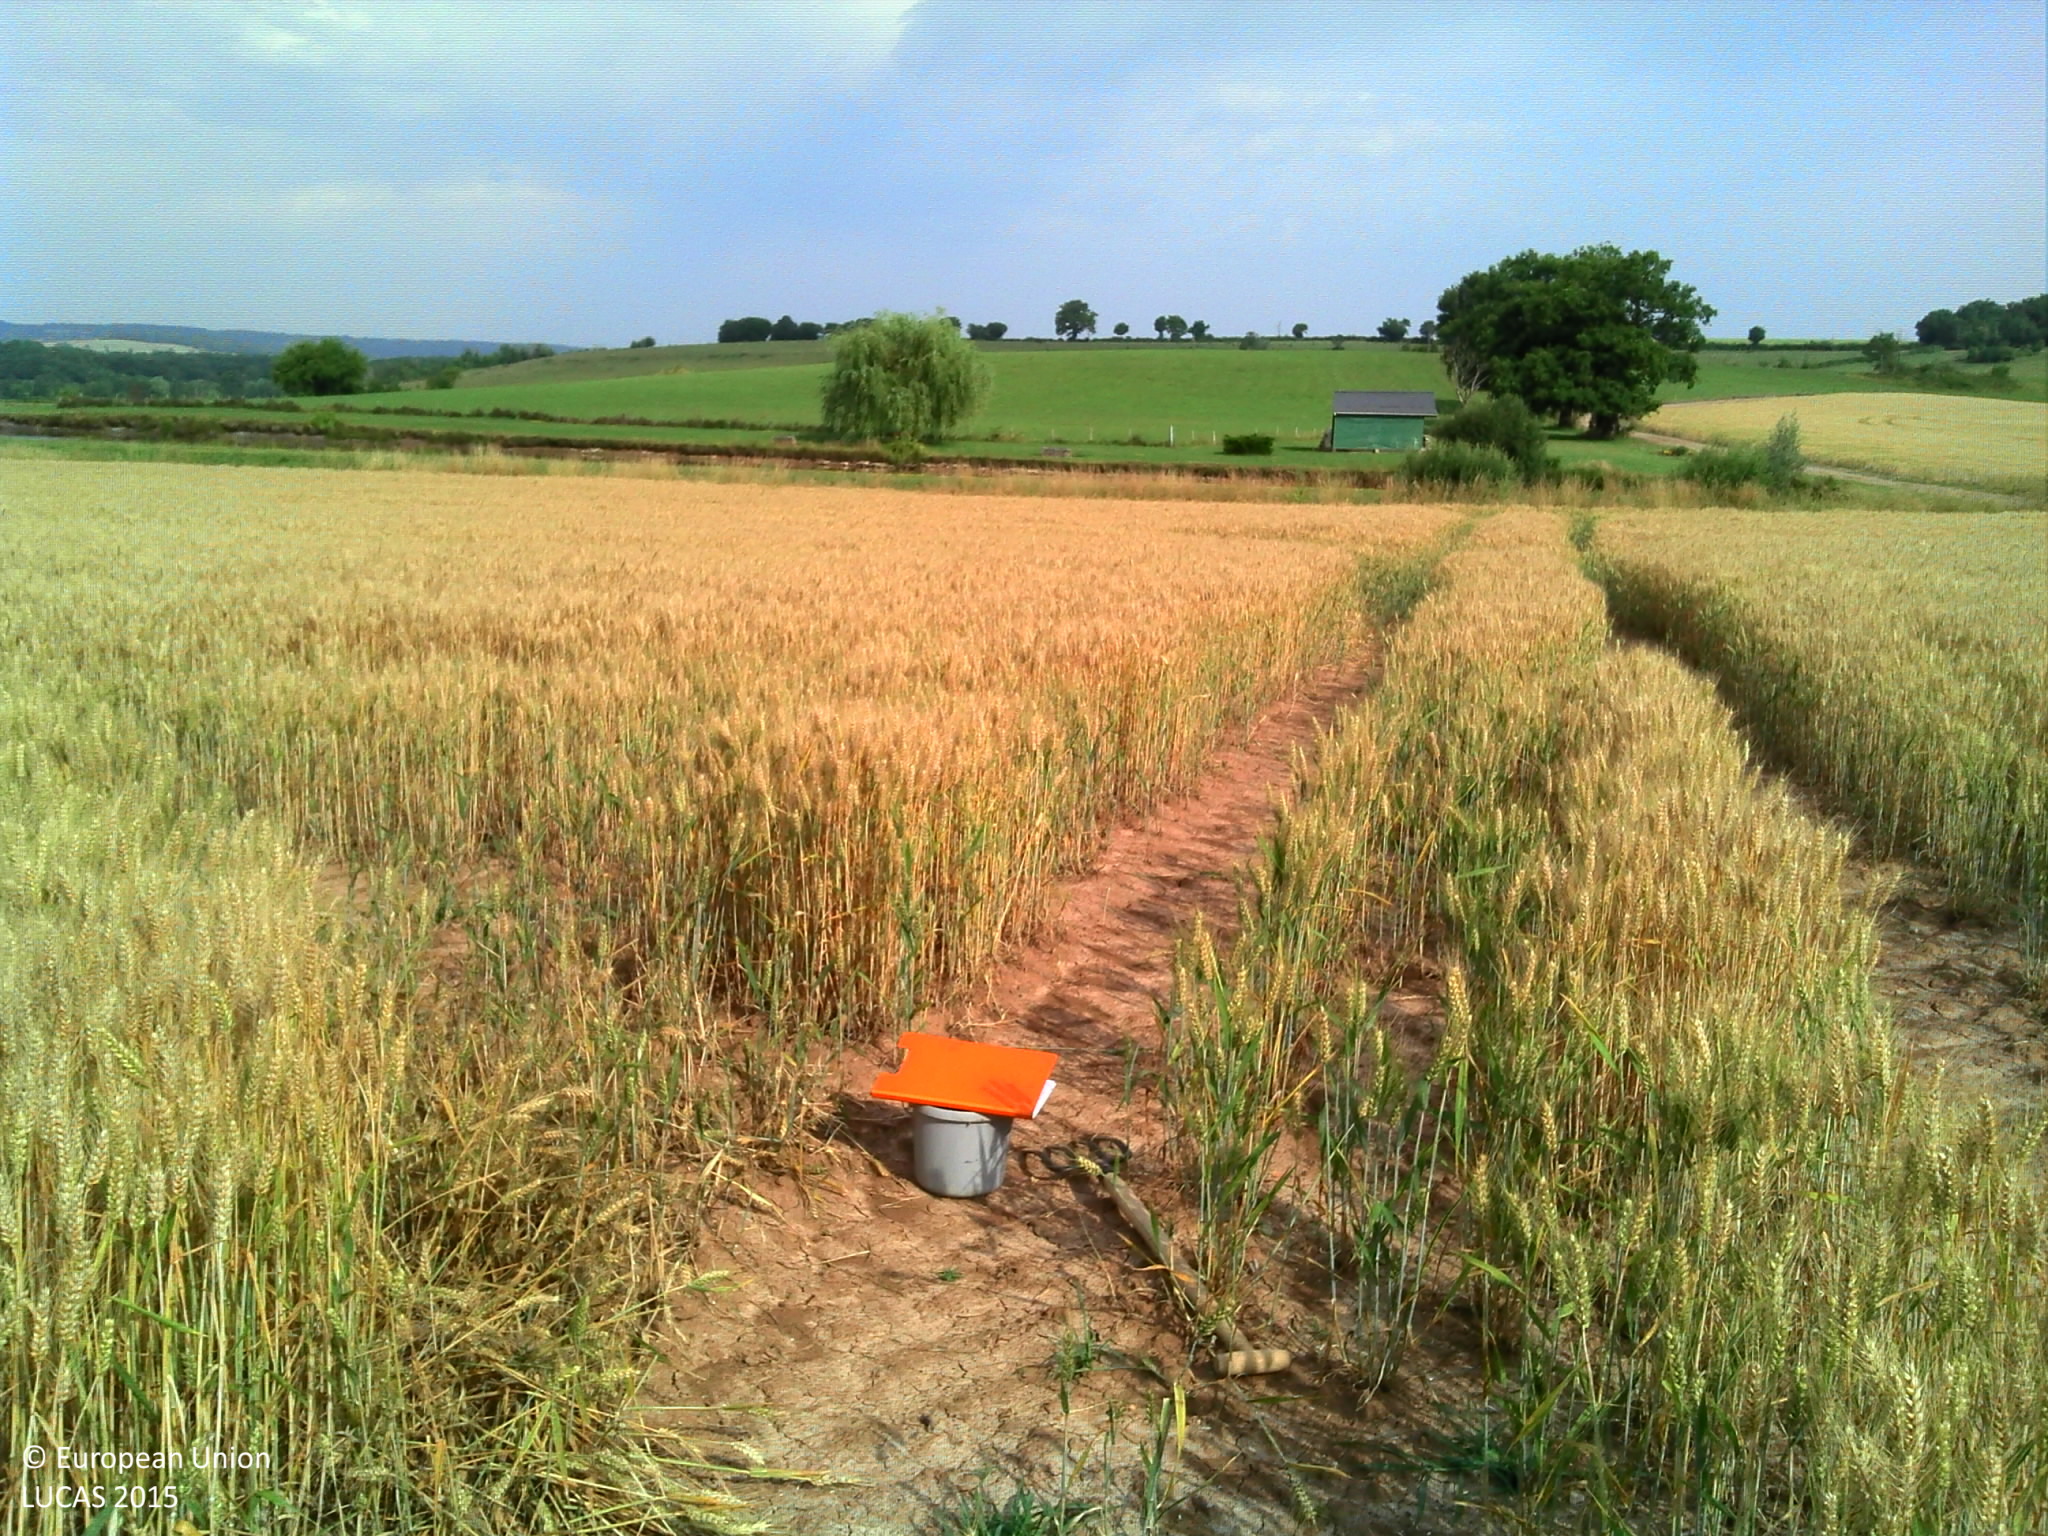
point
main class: Cropland
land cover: Common wheat
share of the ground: > 75 %
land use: Agriculture (excluding fallow land and kitchen gardens)
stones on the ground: < 10 %
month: July
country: FR
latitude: 47.0976
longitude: 3.5812
